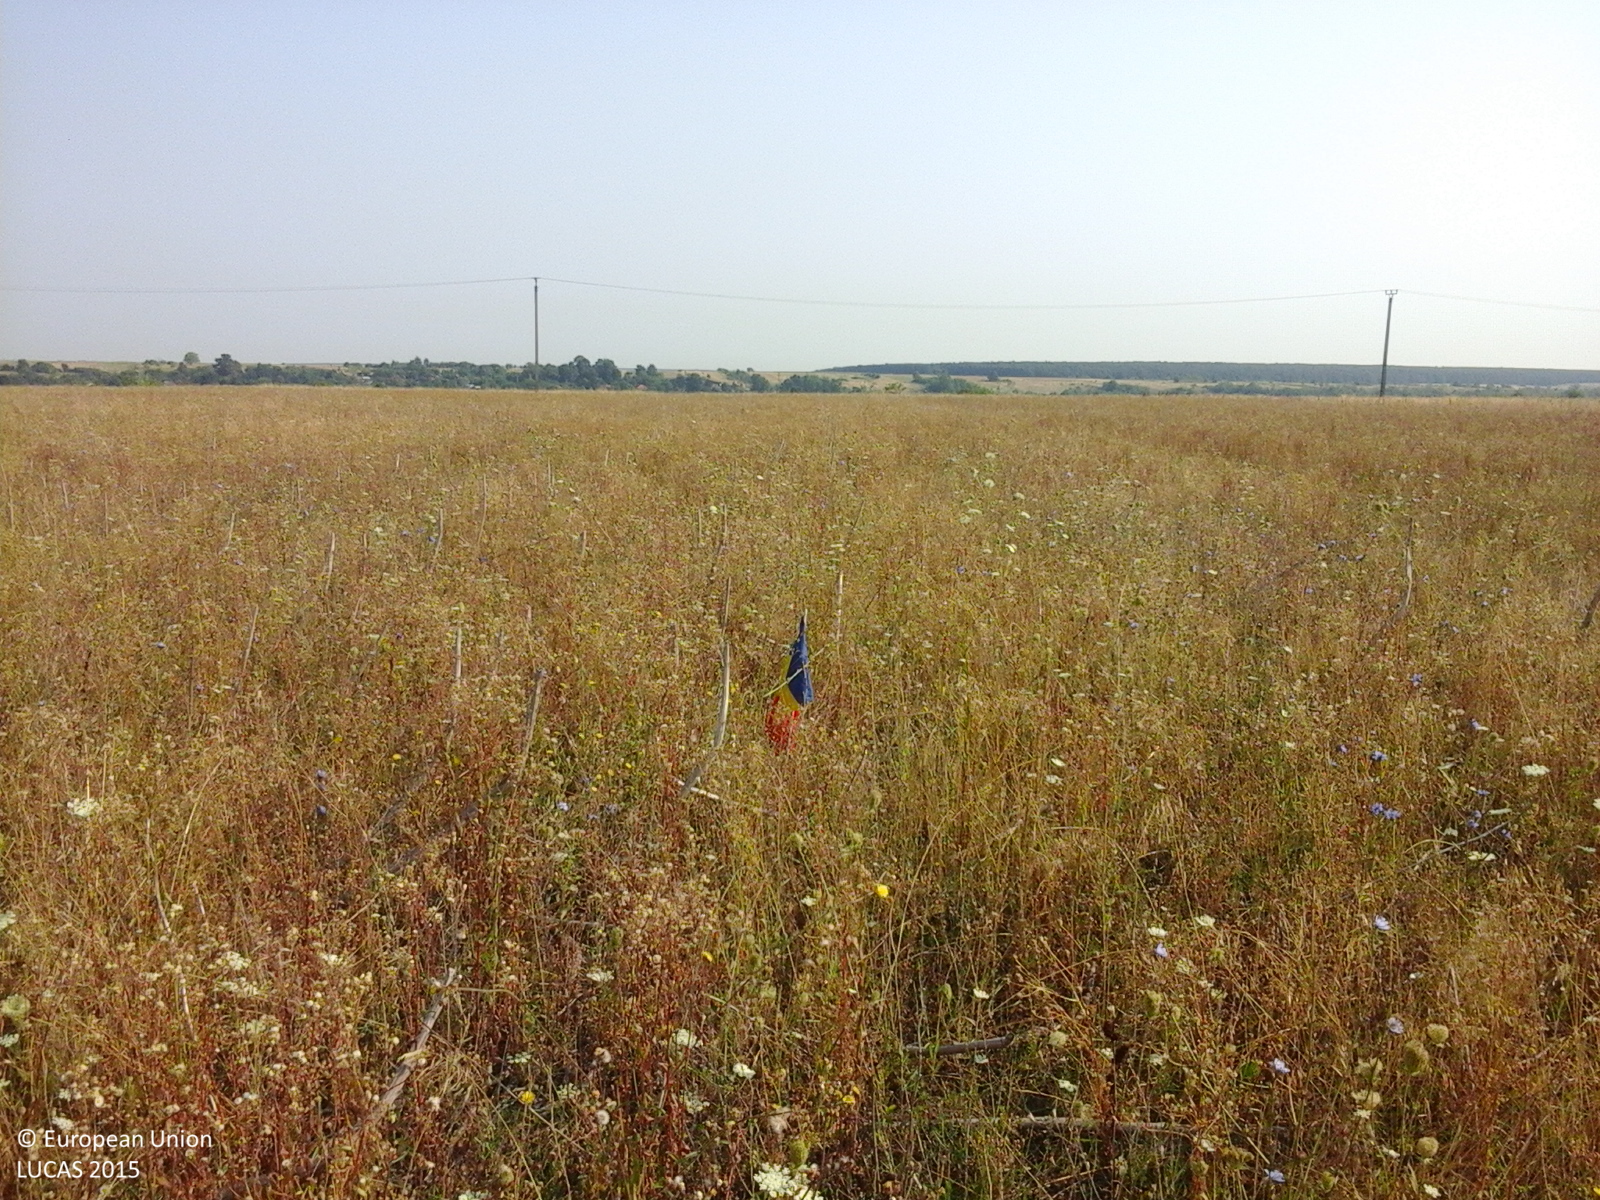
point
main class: Grassland
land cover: Spontaneously vegetated surfaces
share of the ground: > 75 %
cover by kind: herbaceous plants 100 %
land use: Fallow land
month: August
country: RO
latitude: 44.4725
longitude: 23.1849
